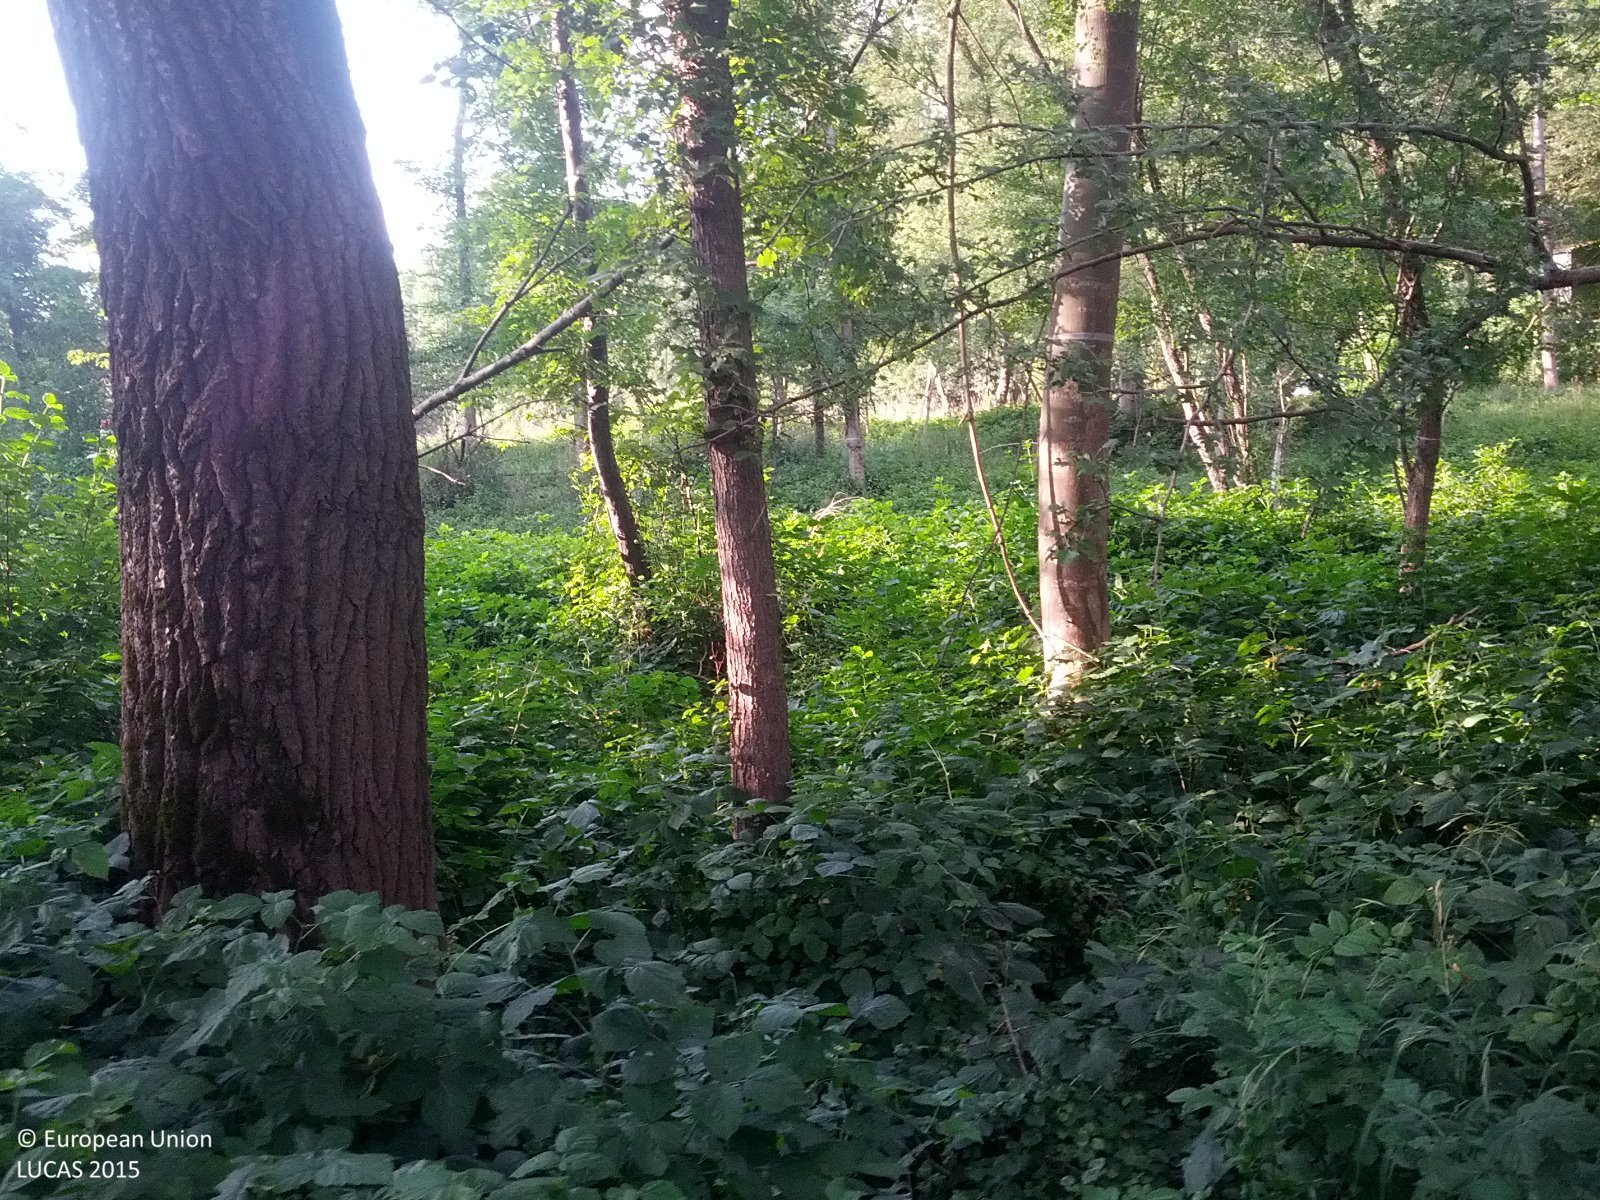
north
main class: Woodland
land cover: Broadleaved woodland
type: floodplain forest
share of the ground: > 75 %
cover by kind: broadleaved forest trees 85 %, herbaceous plants 15 %
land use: Forestry
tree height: > 5 m
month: July
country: AT
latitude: 48.3723
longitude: 16.2282
